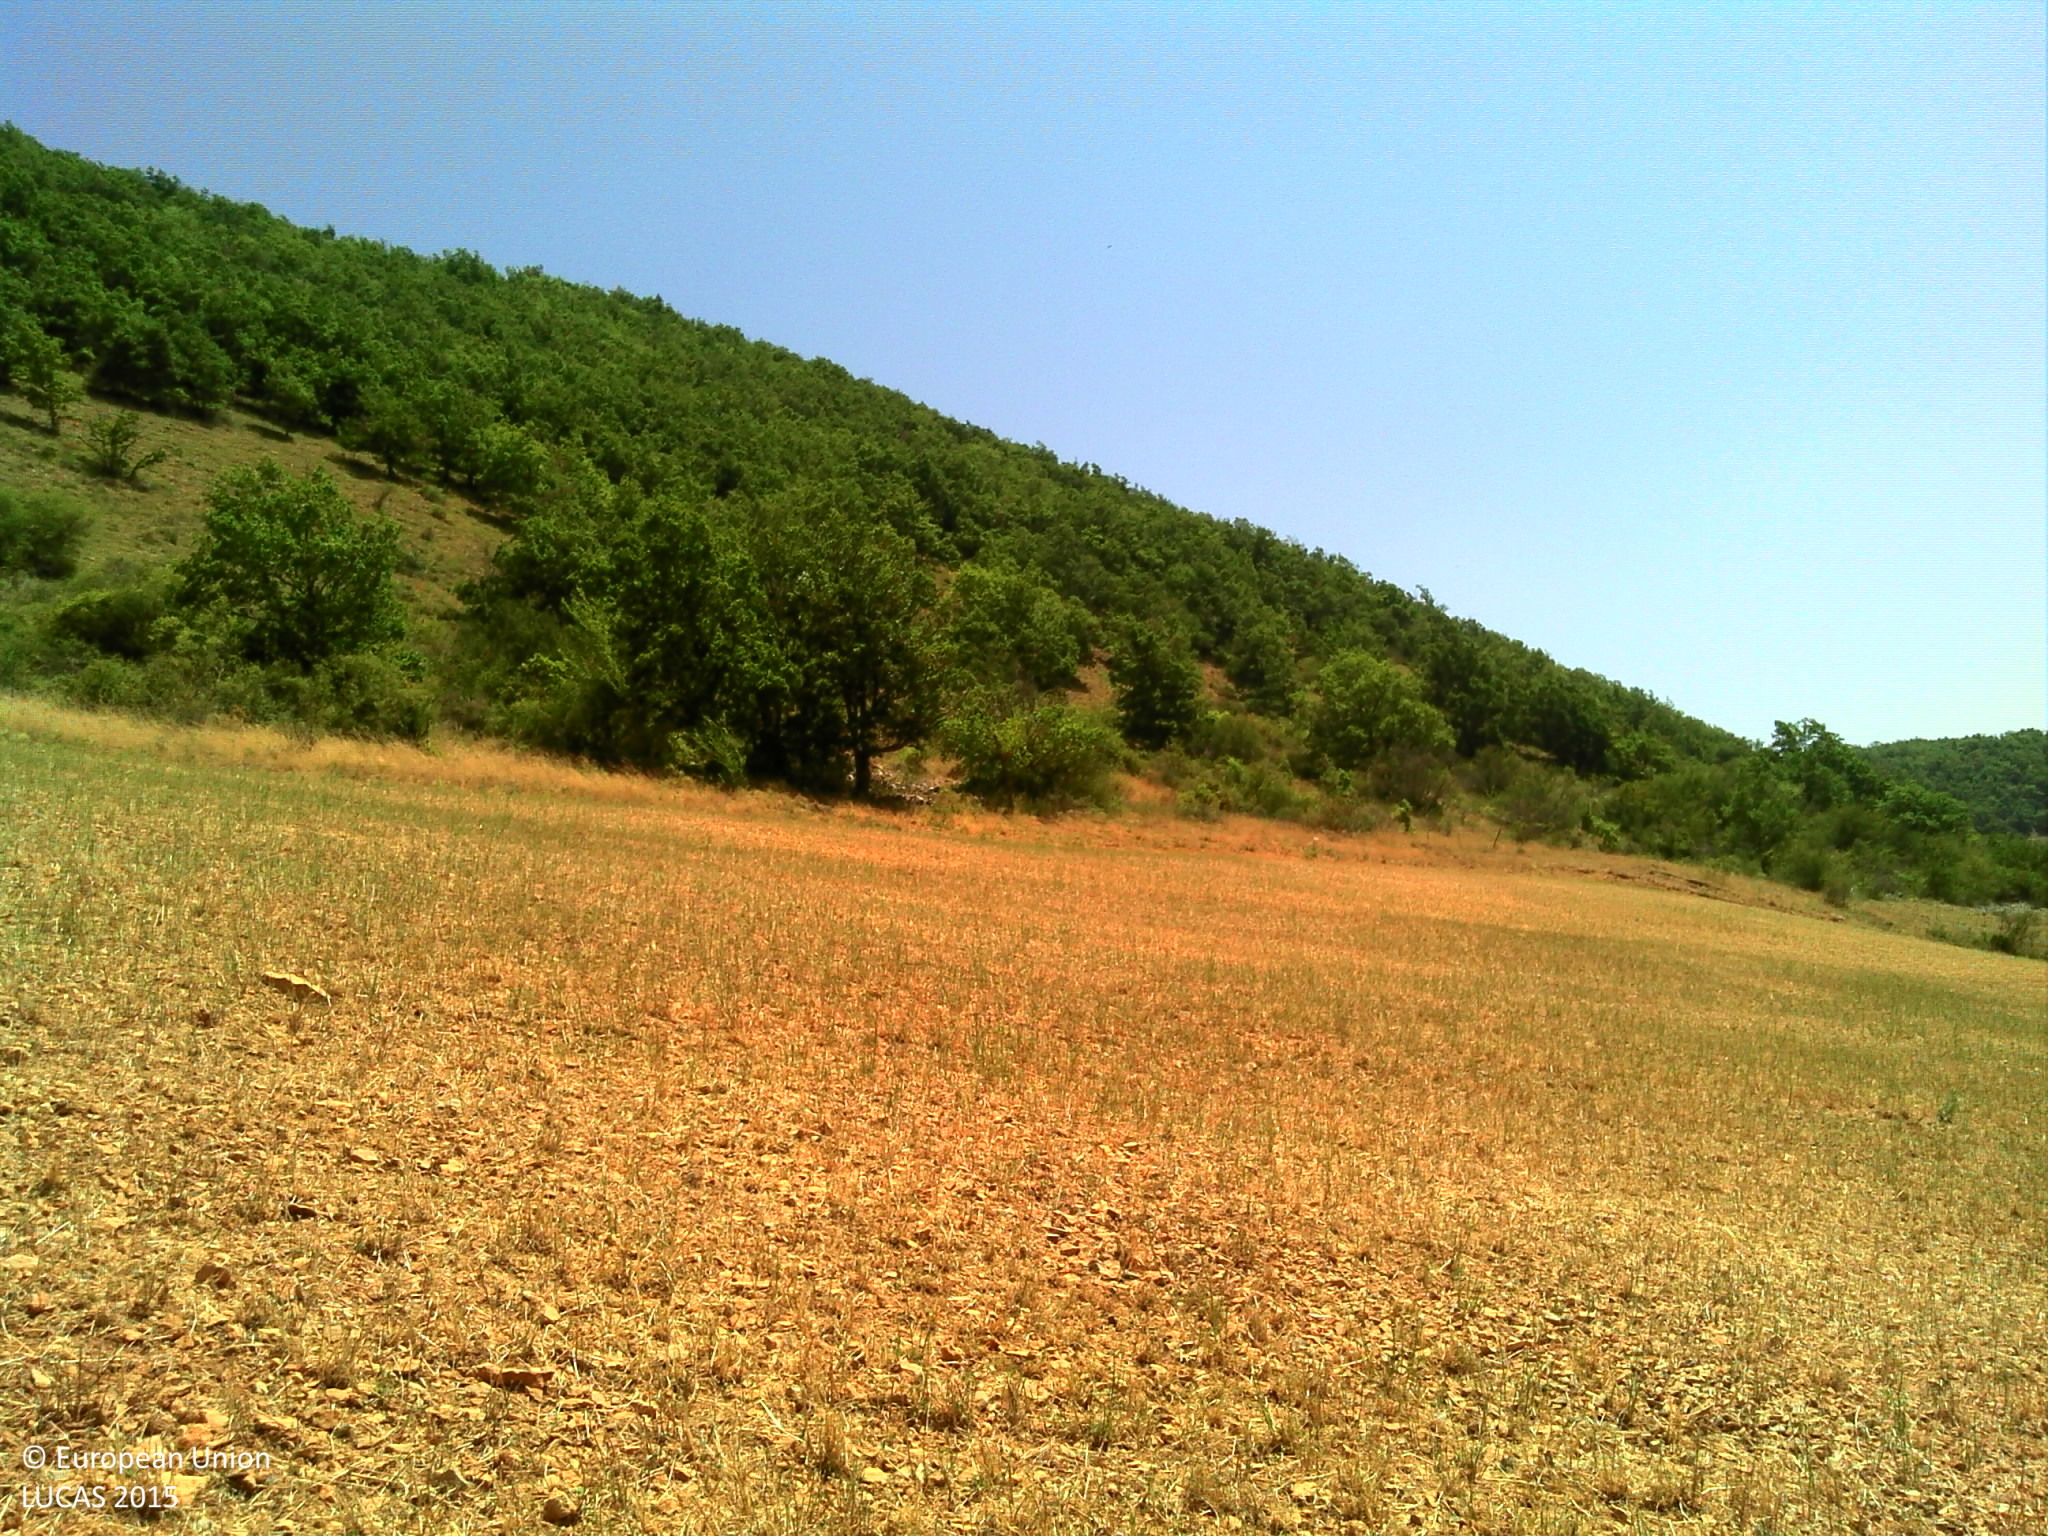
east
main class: Cropland
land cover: Temporary grasslands
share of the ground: 25 - 50 %
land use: Agriculture (excluding fallow land and kitchen gardens)
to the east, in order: Temporary grasslands; Dry stone walls; Shrubland without tree cover; Rocks and stones; Shrubland without tree cover; Shrubland with sparse tree cover; Broadleaved woodland
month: July
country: FR
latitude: 44.1367
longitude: 3.0684
